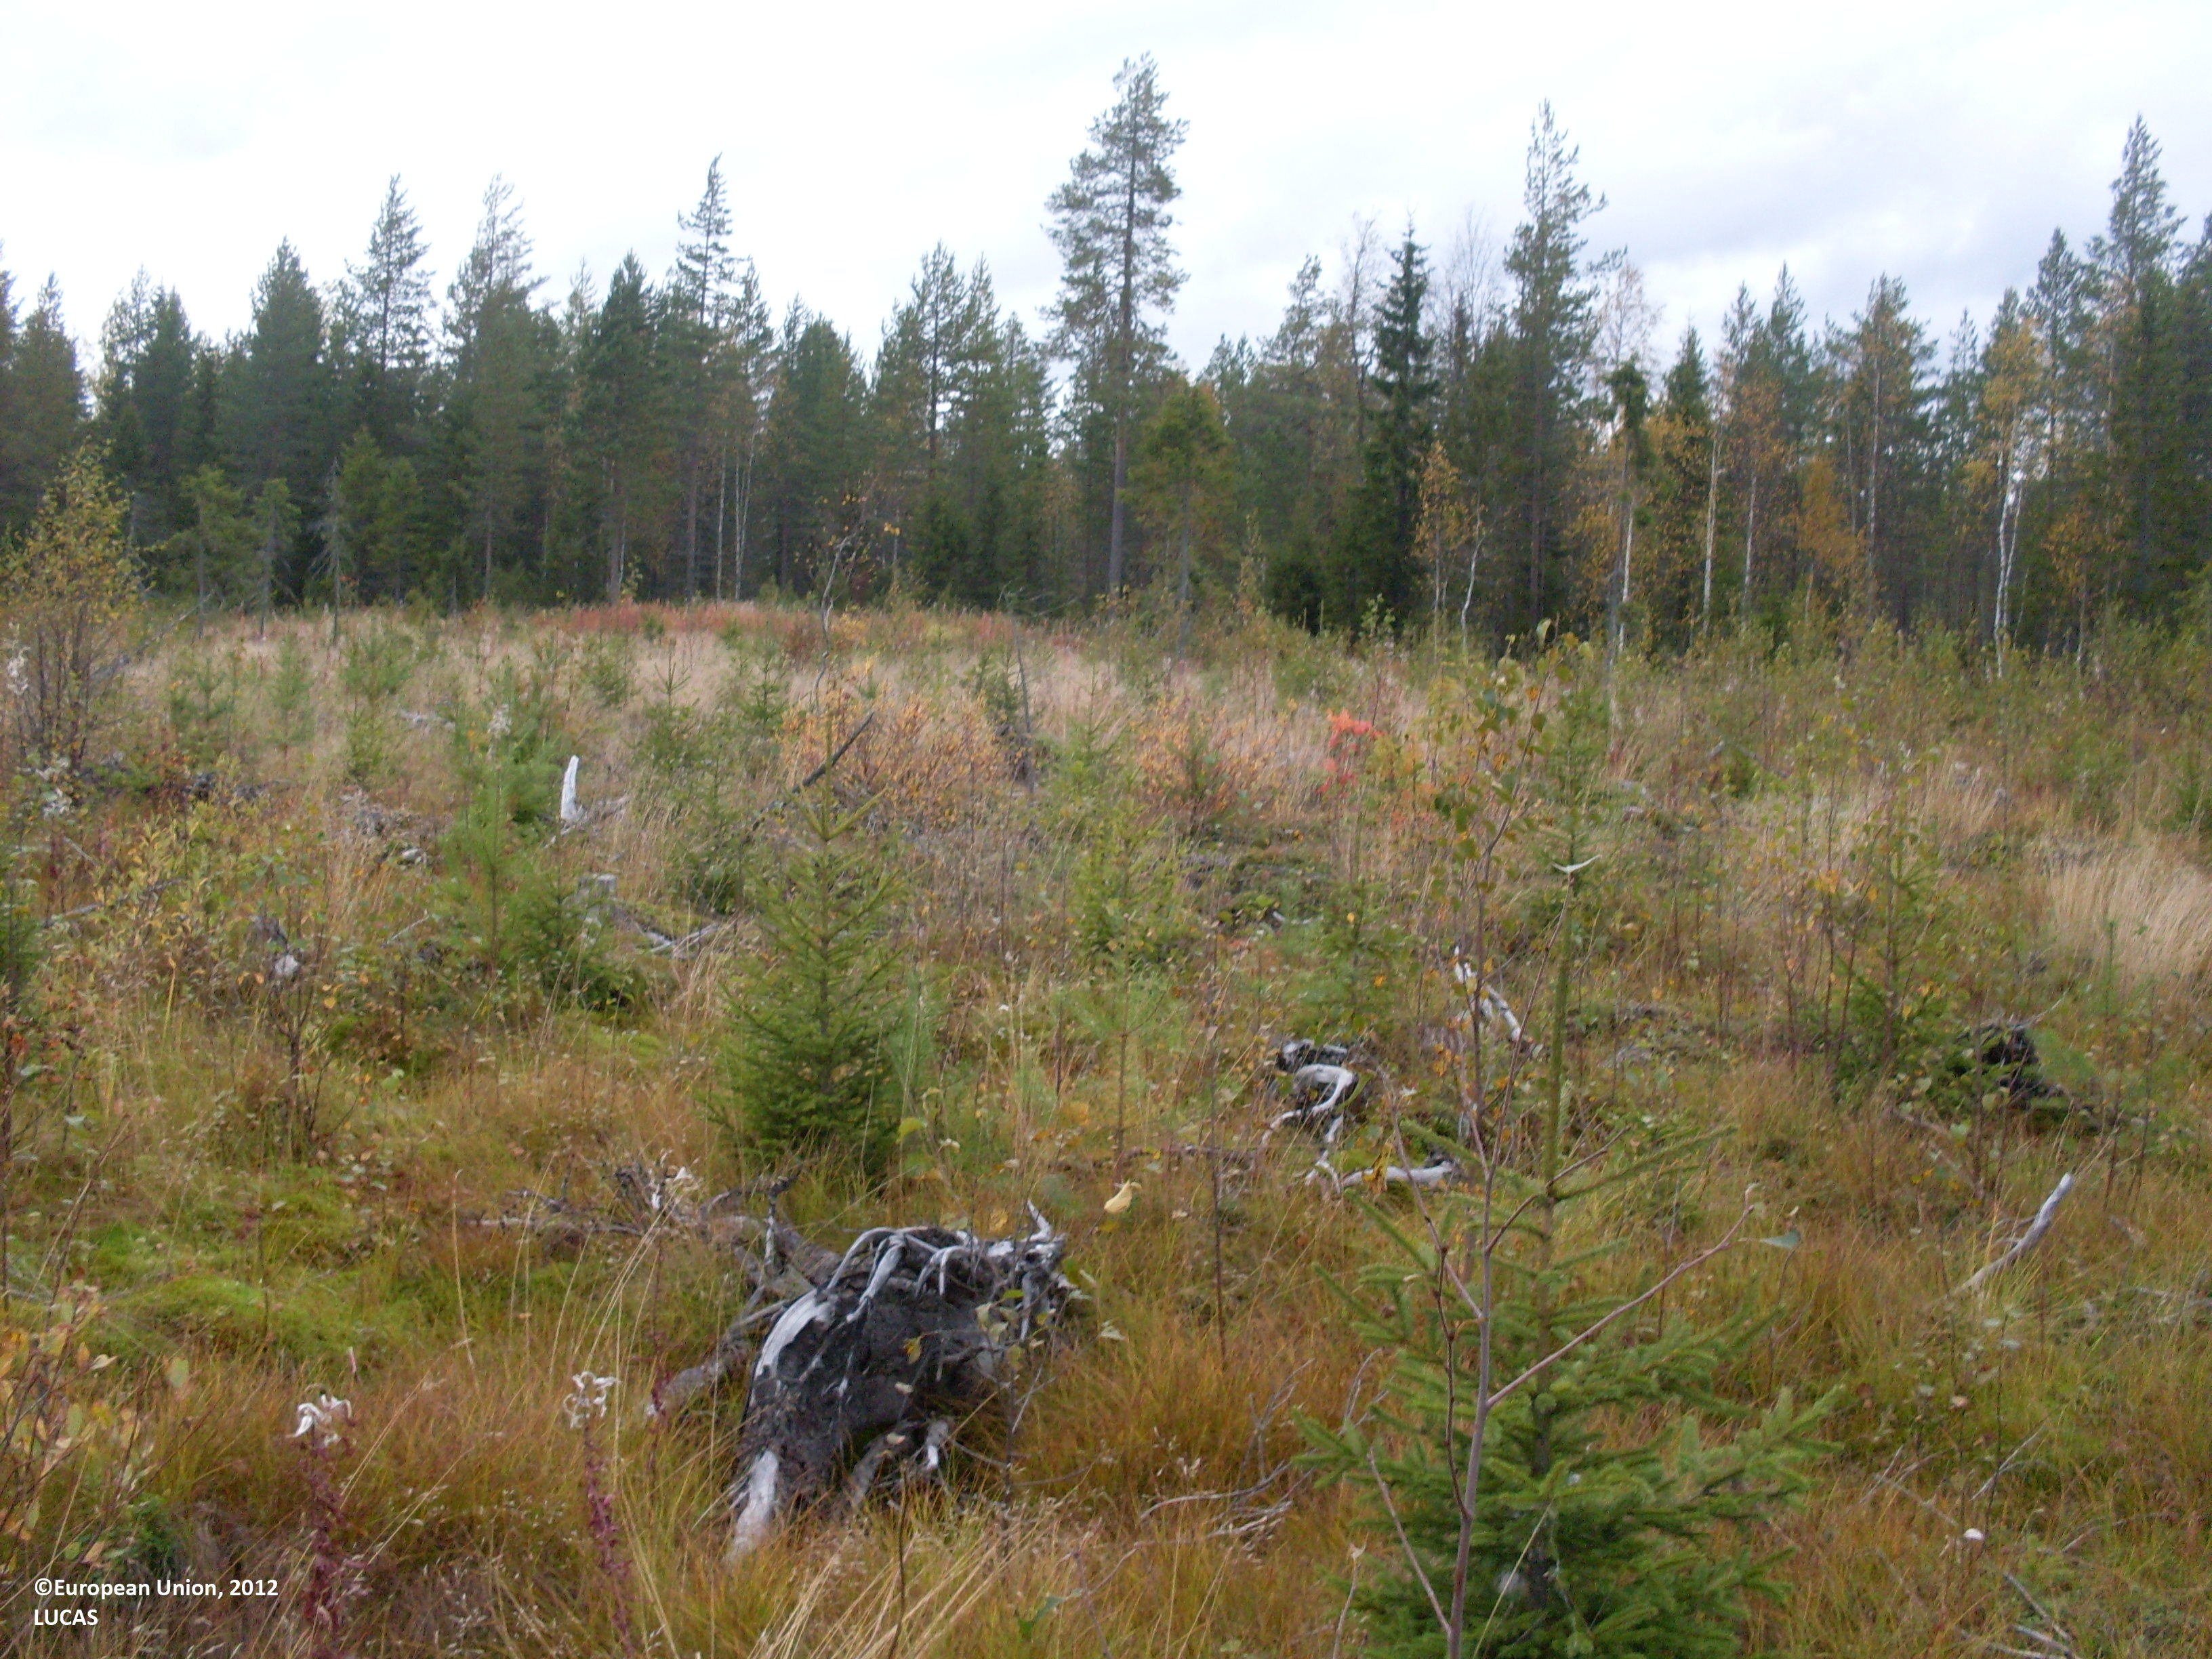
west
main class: Woodland
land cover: Pine dominated mixed woodland
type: boreal forest
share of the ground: 25 - 50 %
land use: Forestry
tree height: < 5 m
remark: Nursery
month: September
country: FI
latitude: 64.2807
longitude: 28.3700
